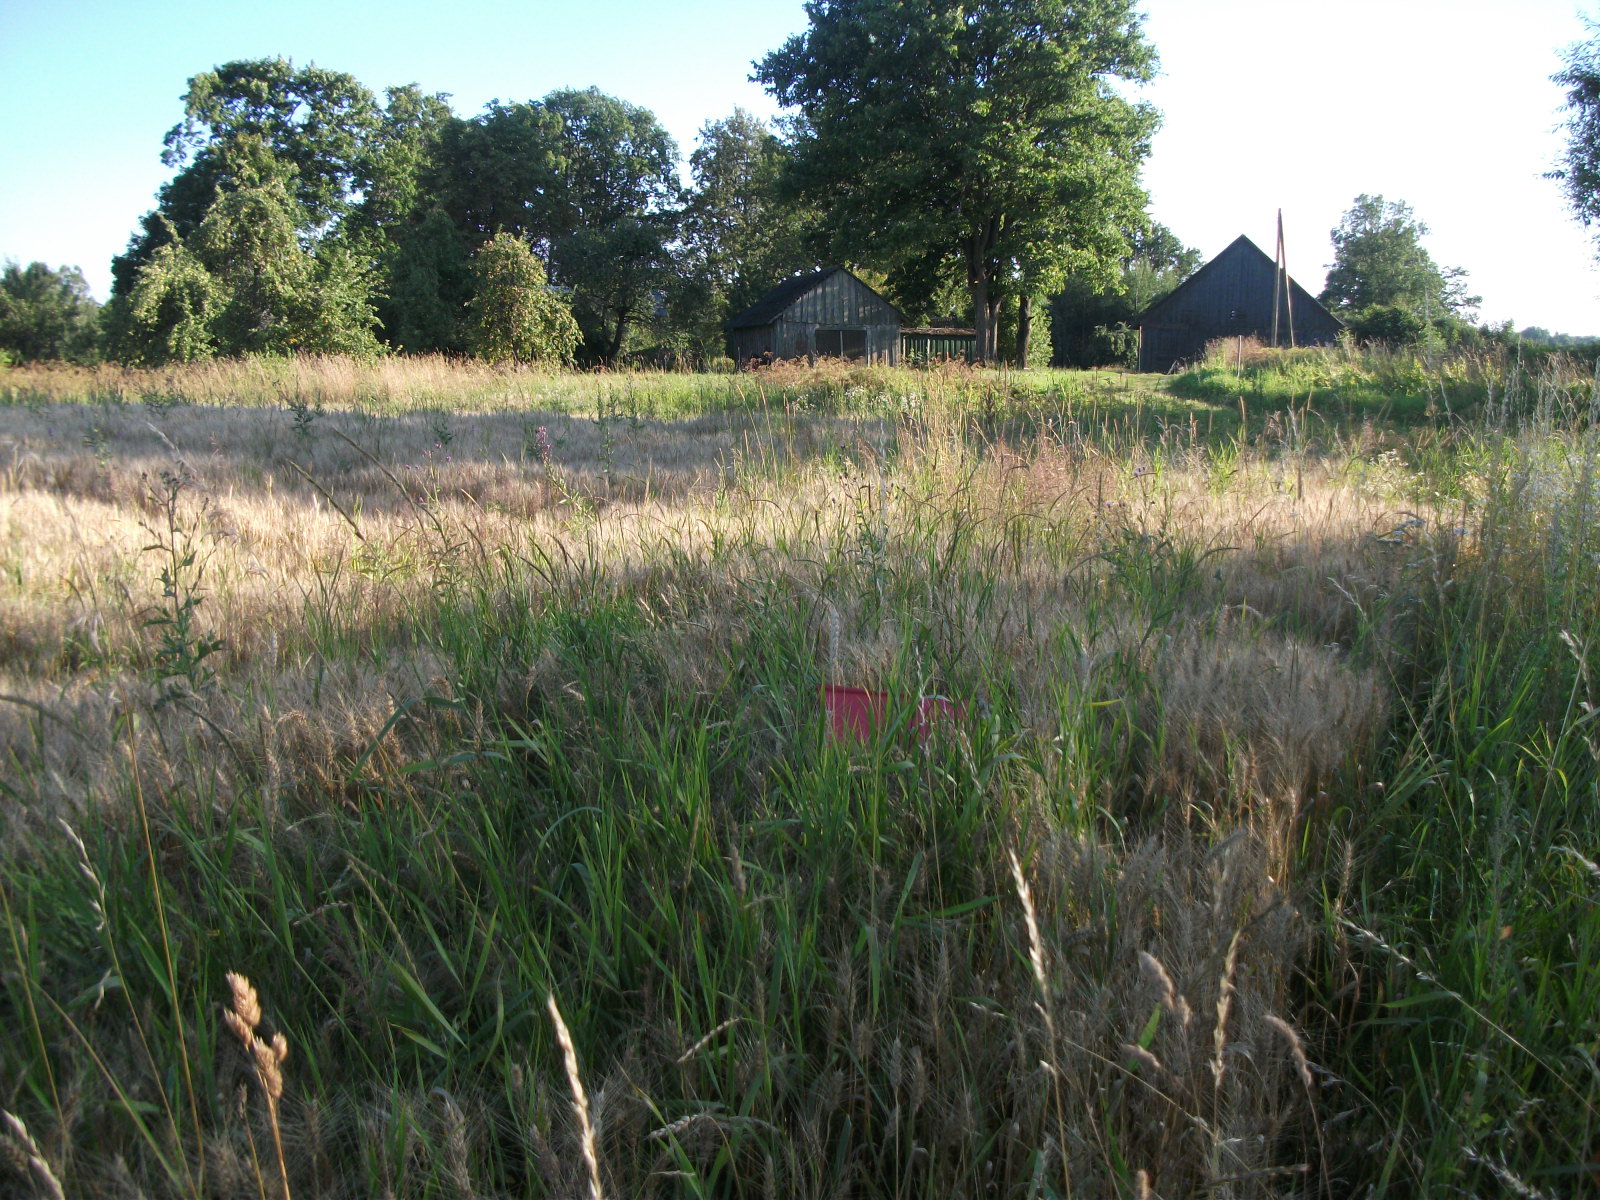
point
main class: Cropland
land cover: Common wheat
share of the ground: > 75 %
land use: Agriculture (excluding fallow land and kitchen gardens)
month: August
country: LV
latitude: 57.0573
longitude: 26.5182
